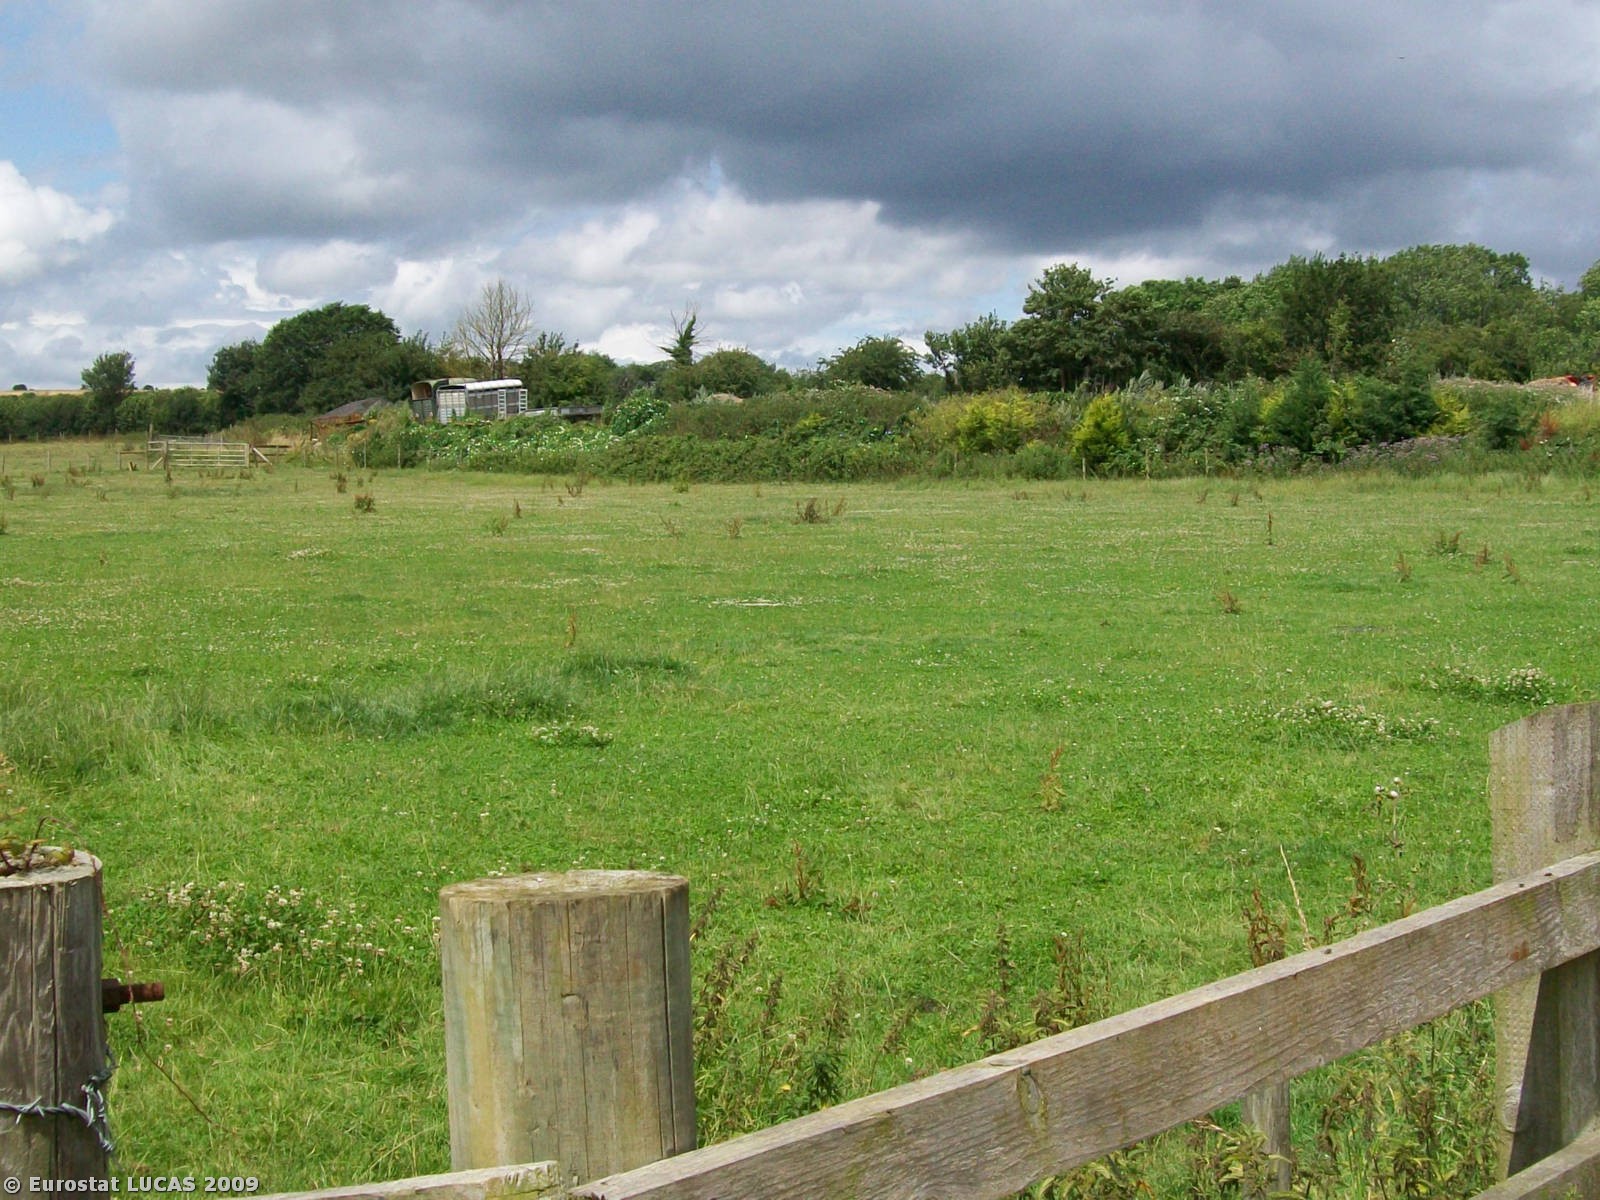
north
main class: Grassland
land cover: Grassland without tree/shrub cover
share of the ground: > 75 %
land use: Agriculture (excluding fallow land and kitchen gardens)
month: July
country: GB
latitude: 51.3959
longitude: -2.2358
